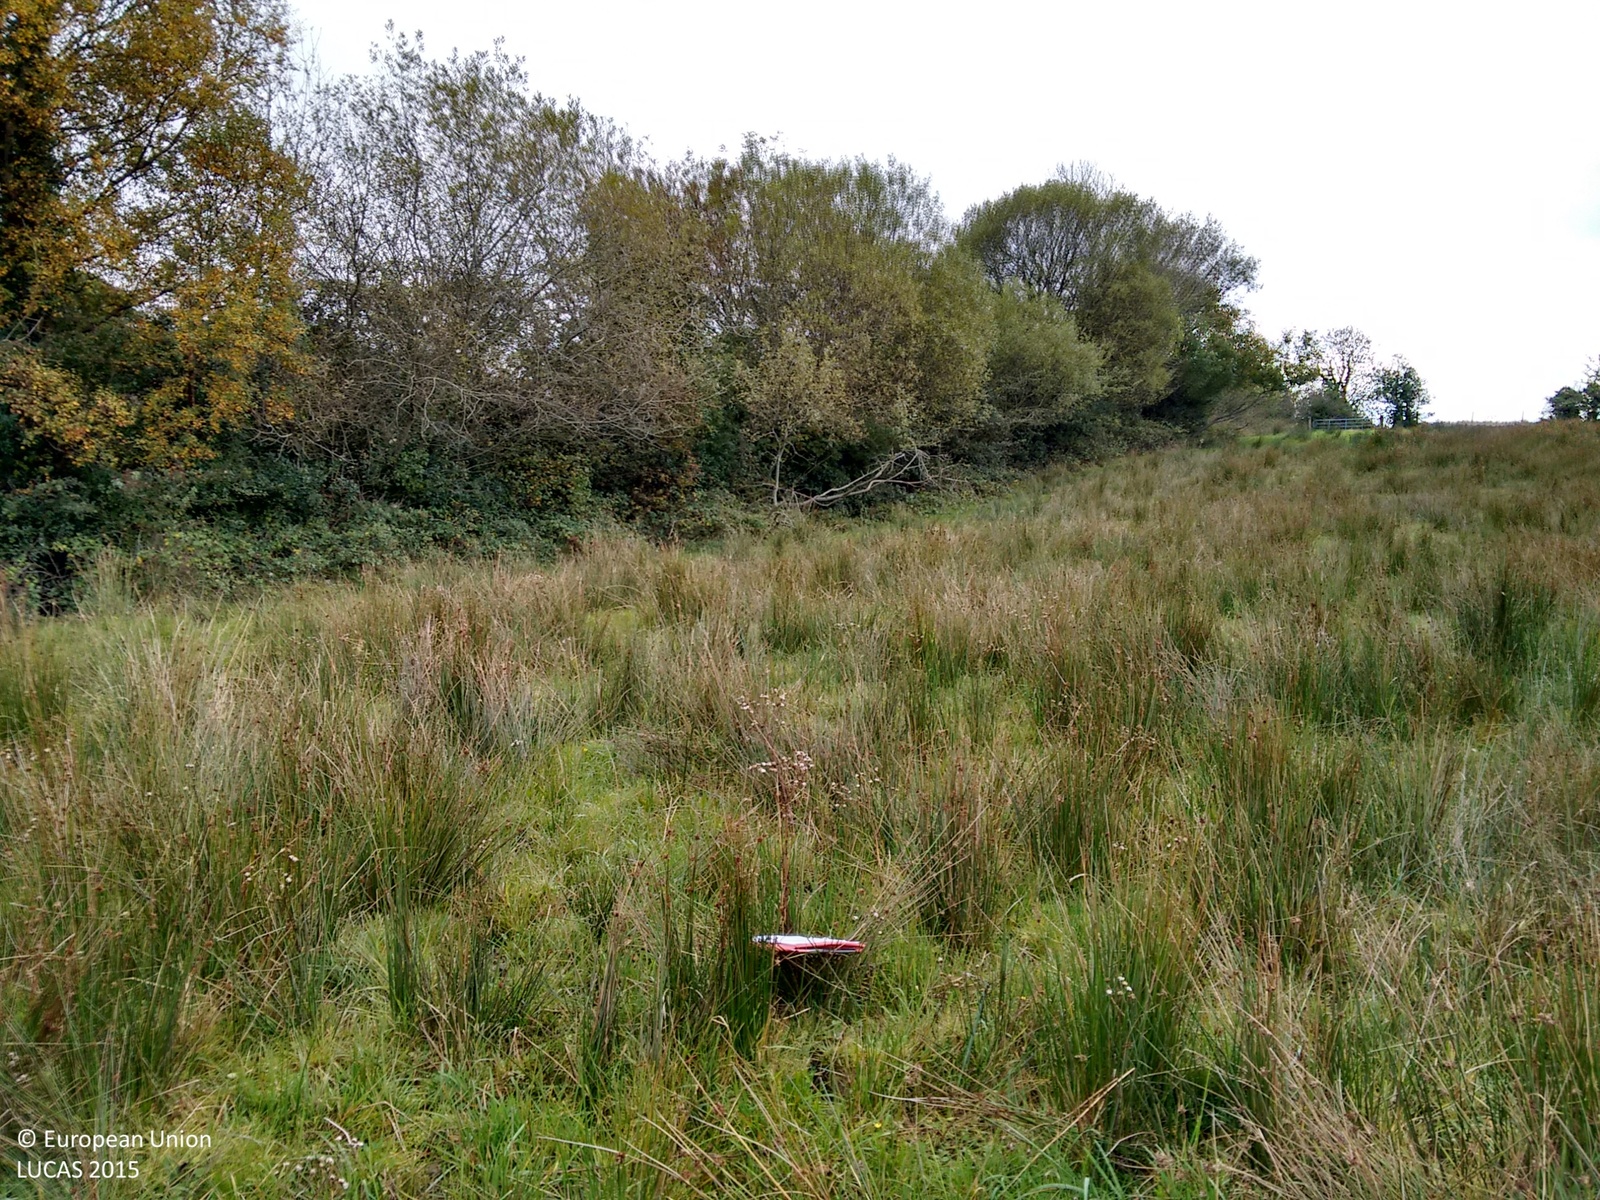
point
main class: Grassland
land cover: Grassland without tree/shrub cover
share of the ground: > 75 %
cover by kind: herbaceous plants 100 %
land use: Agriculture (excluding fallow land and kitchen gardens)
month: October
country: GB
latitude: 54.5132
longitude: -7.8539
